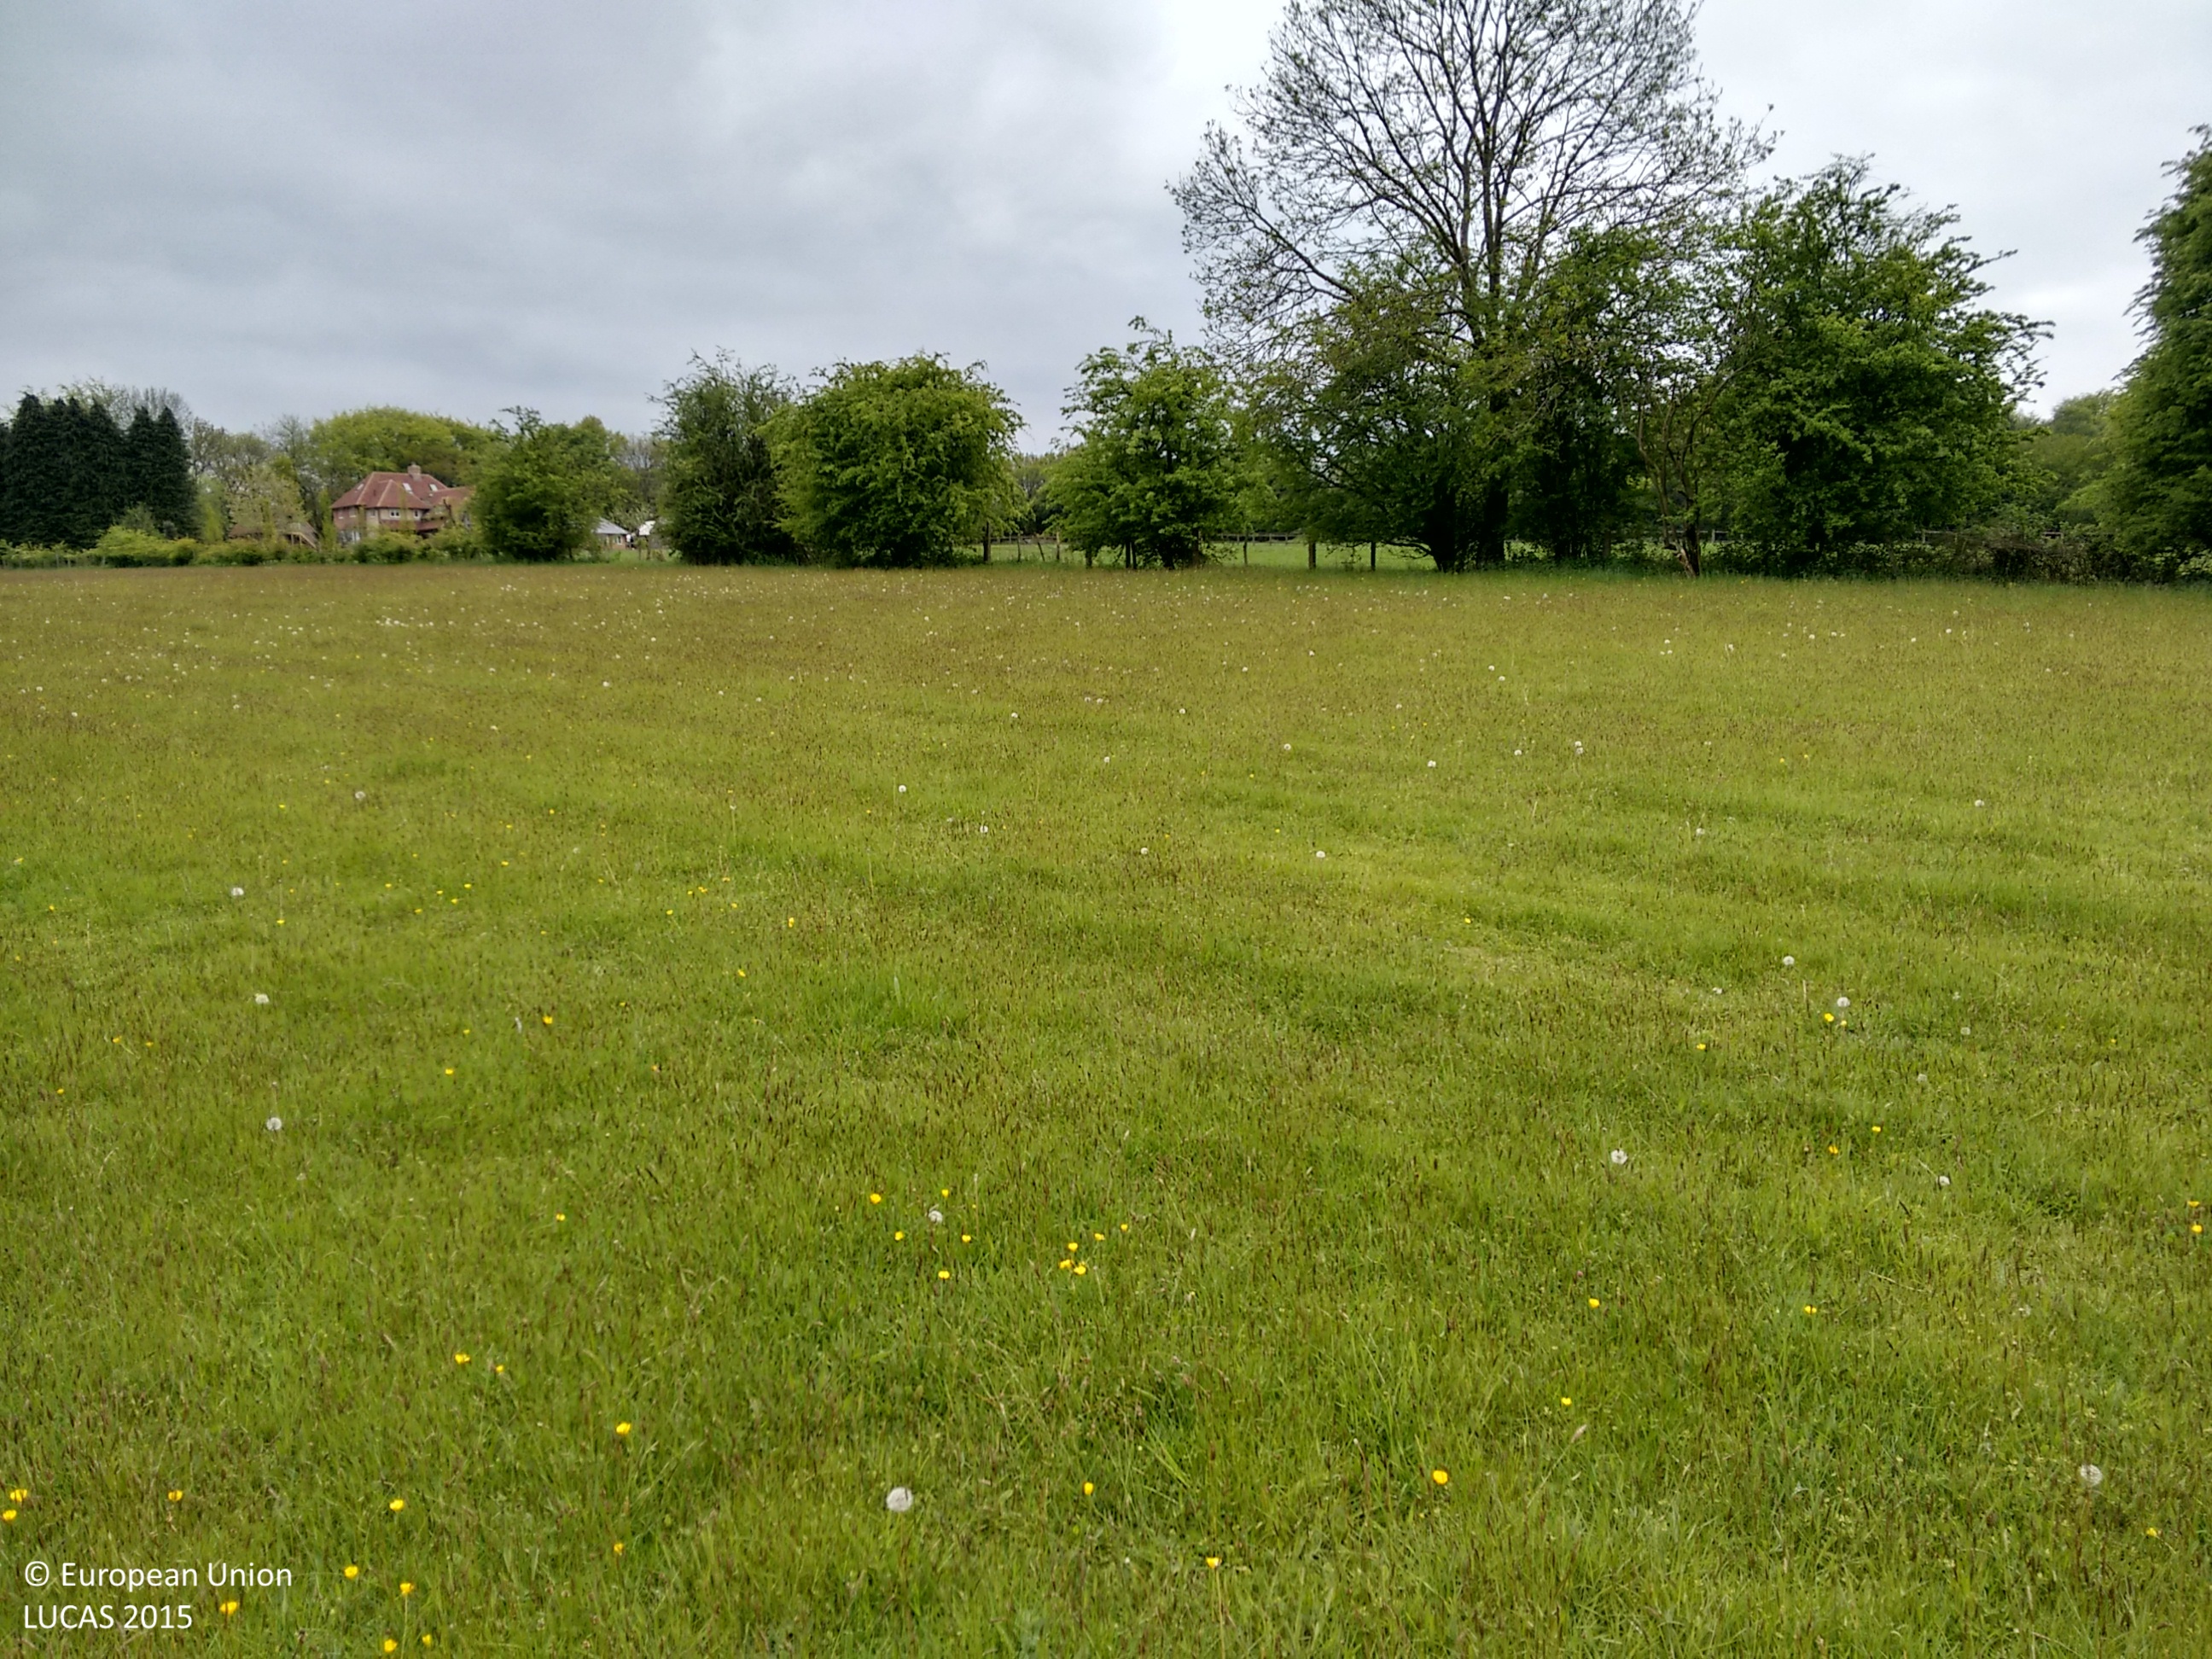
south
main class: Grassland
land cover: Grassland without tree/shrub cover
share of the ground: > 75 %
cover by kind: herbaceous plants 100 %
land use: Agriculture (excluding fallow land and kitchen gardens)
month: May
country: GB
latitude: 51.0315
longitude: -0.9811
